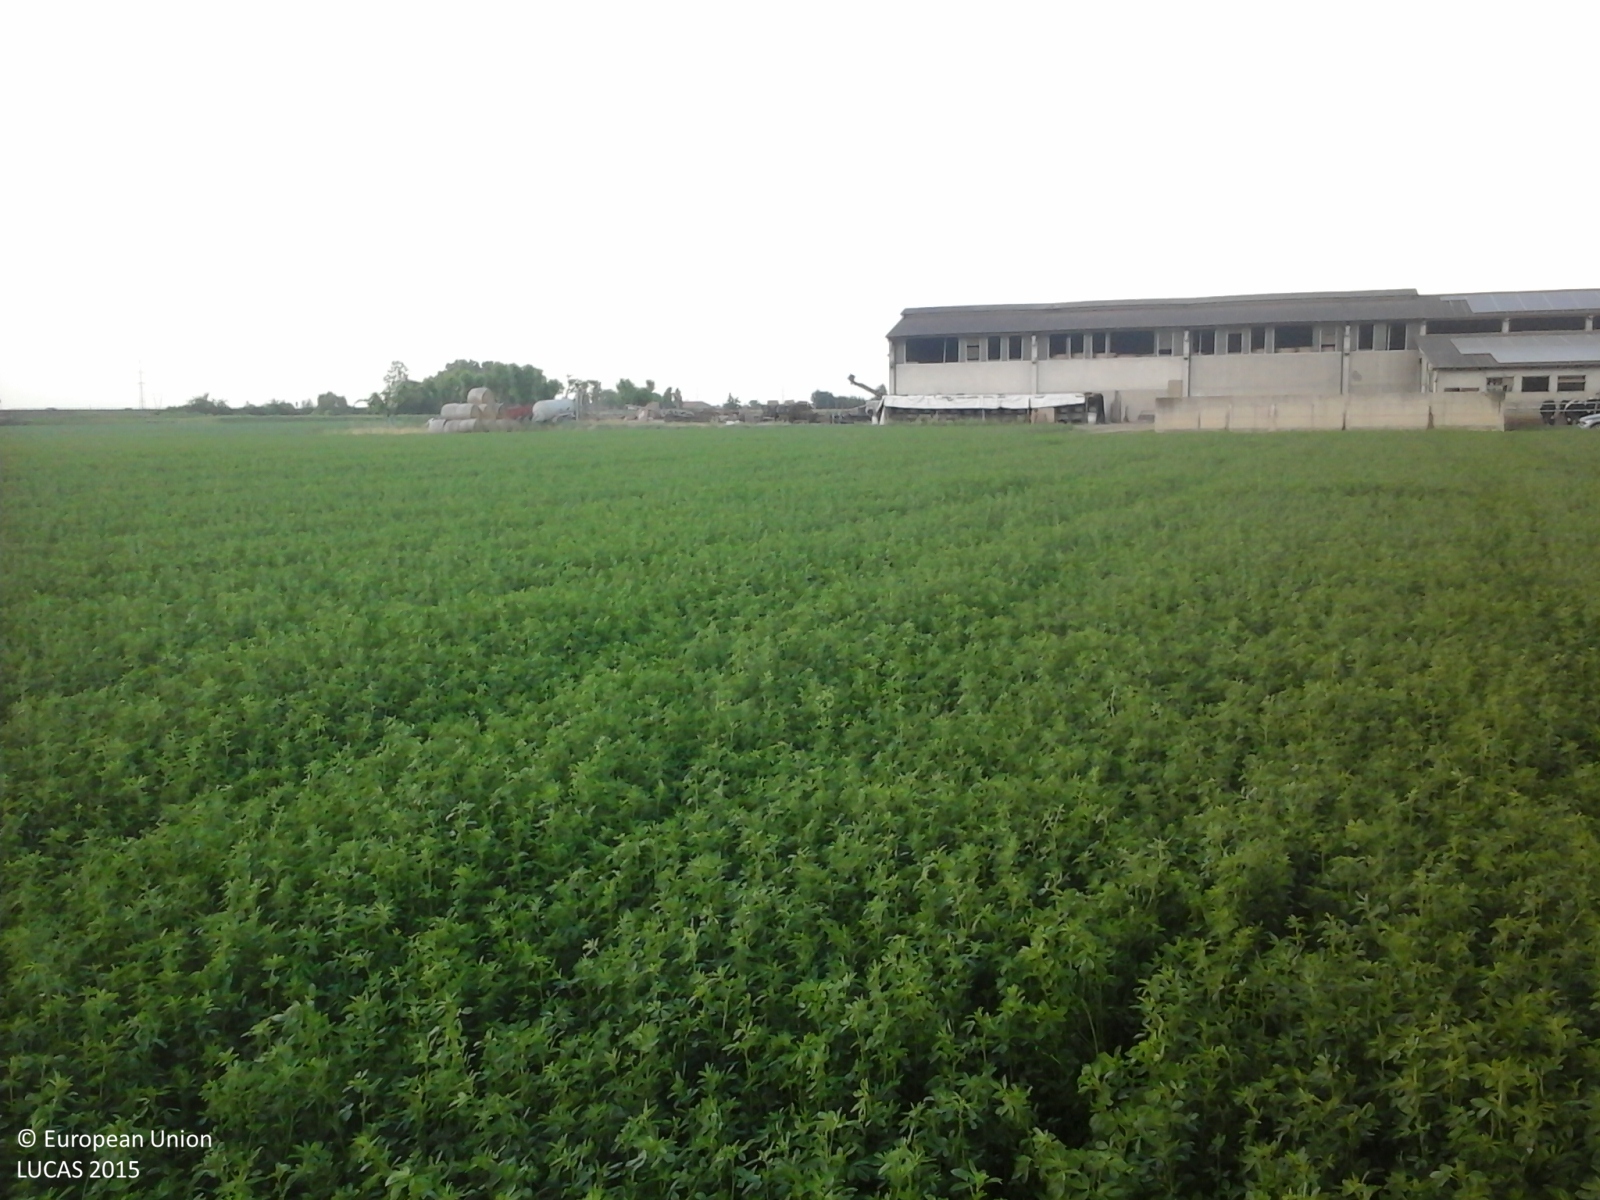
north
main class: Cropland
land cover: Lucerne
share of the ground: > 75 %
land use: Agriculture (excluding fallow land and kitchen gardens)
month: May
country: IT
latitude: 45.0684
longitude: 10.8493
